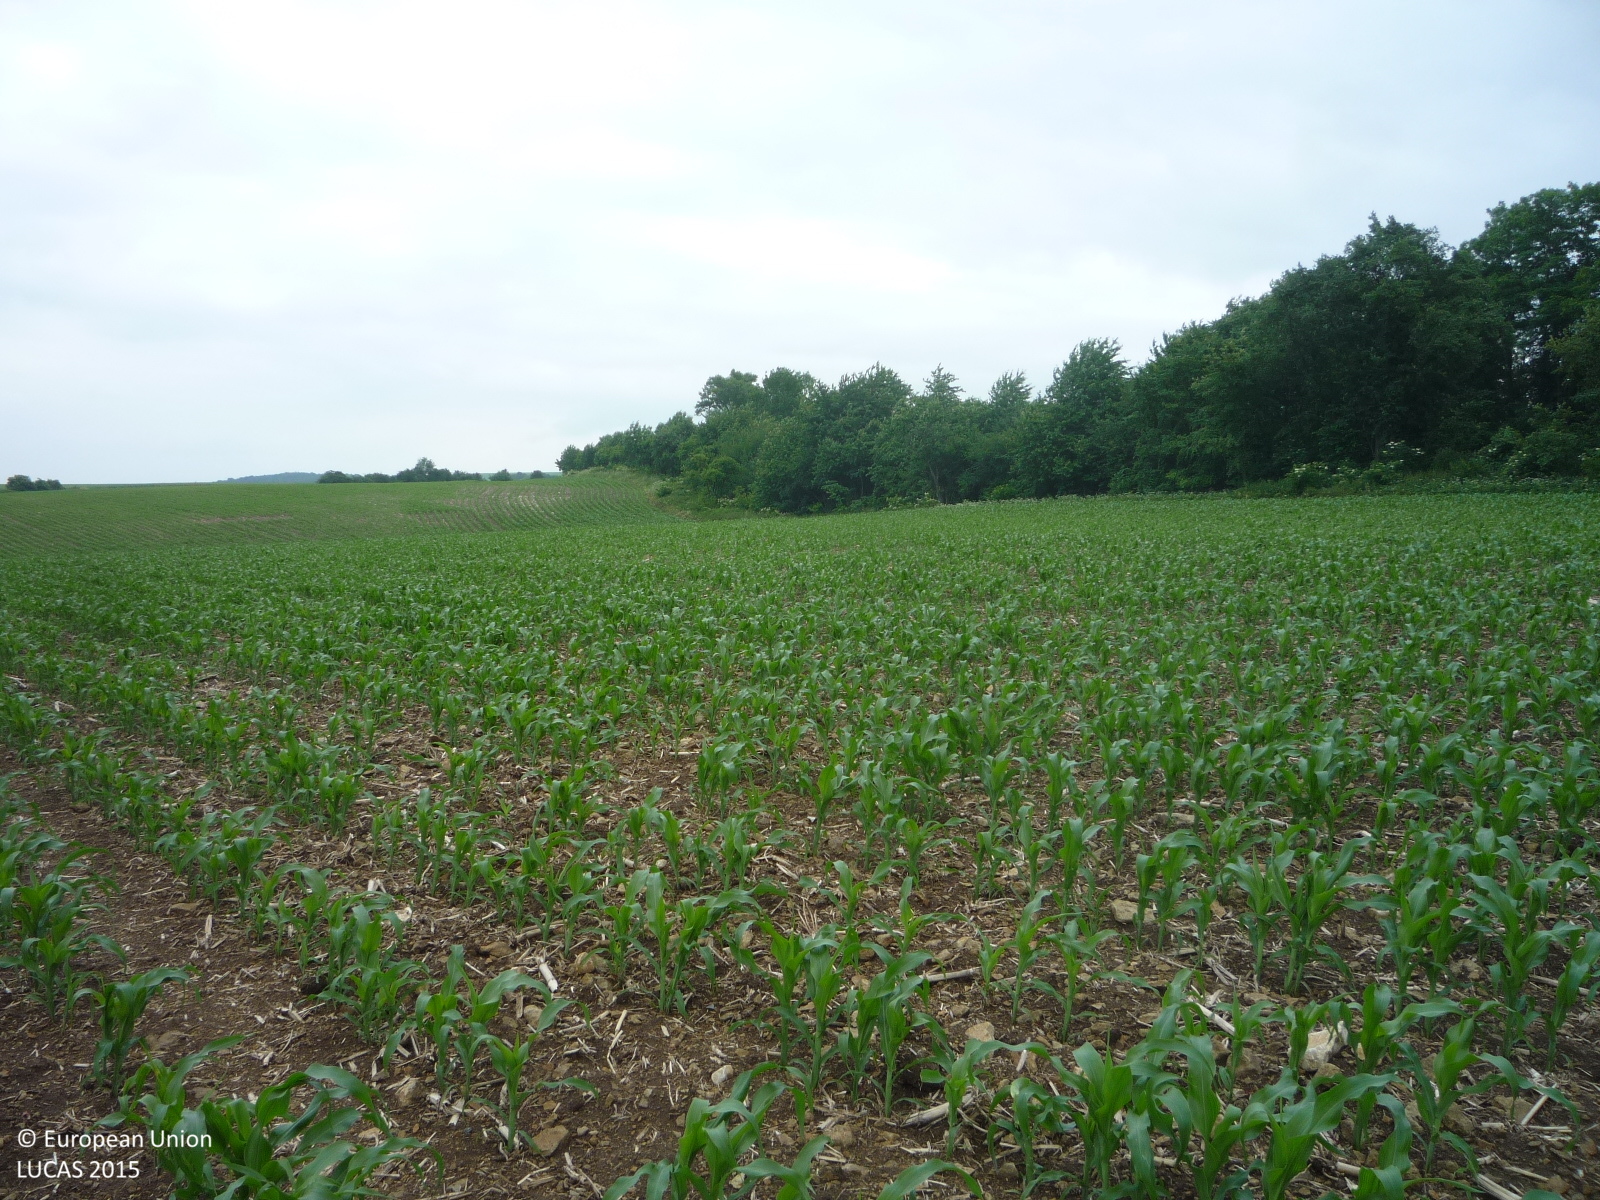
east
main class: Cropland
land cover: Maize
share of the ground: 25 - 50 %
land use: Agriculture (excluding fallow land and kitchen gardens)
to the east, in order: Maize; Grass margins; Broadleaved woodland; Railways; Shrubland with sparse tree cover
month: June
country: CZ
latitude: 50.3348
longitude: 13.8643
